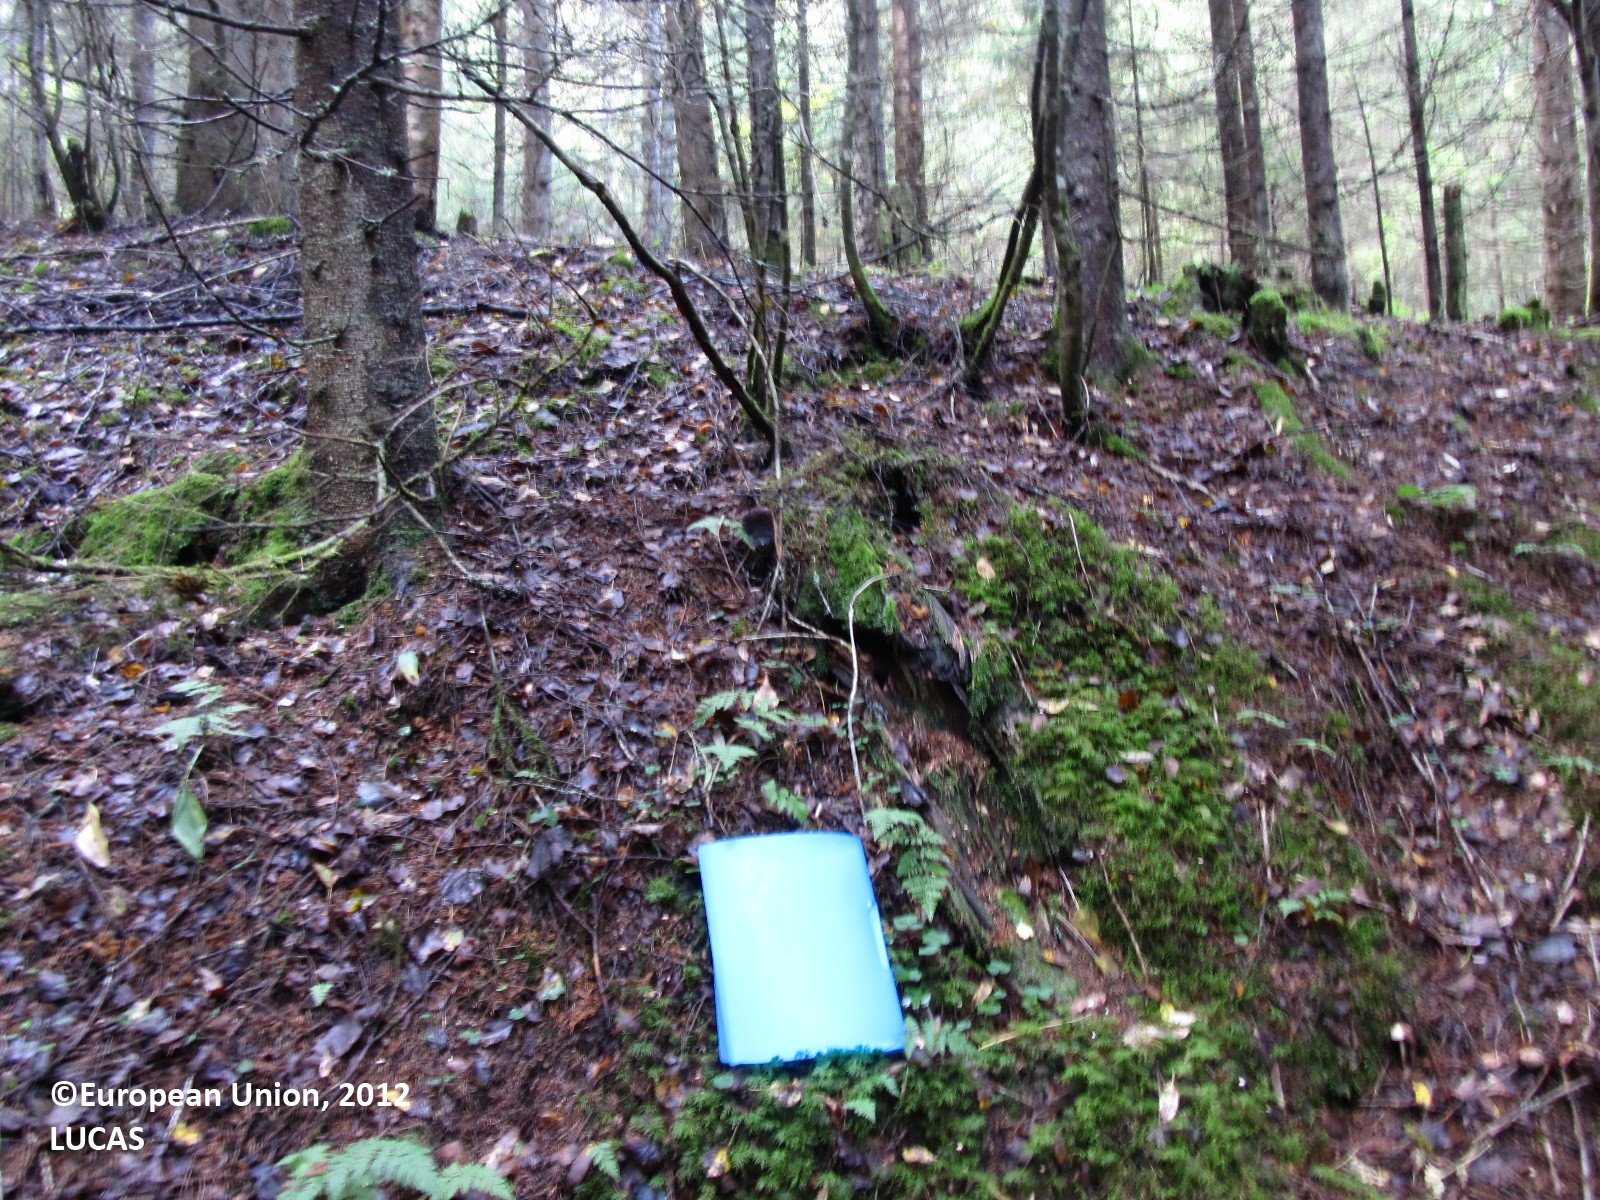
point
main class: Woodland
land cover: Spruce dominated coniferous woodland
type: boreal forest
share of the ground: > 75 %
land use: Forestry
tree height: > 5 m
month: September
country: FI
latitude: 63.2365
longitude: 28.3607
